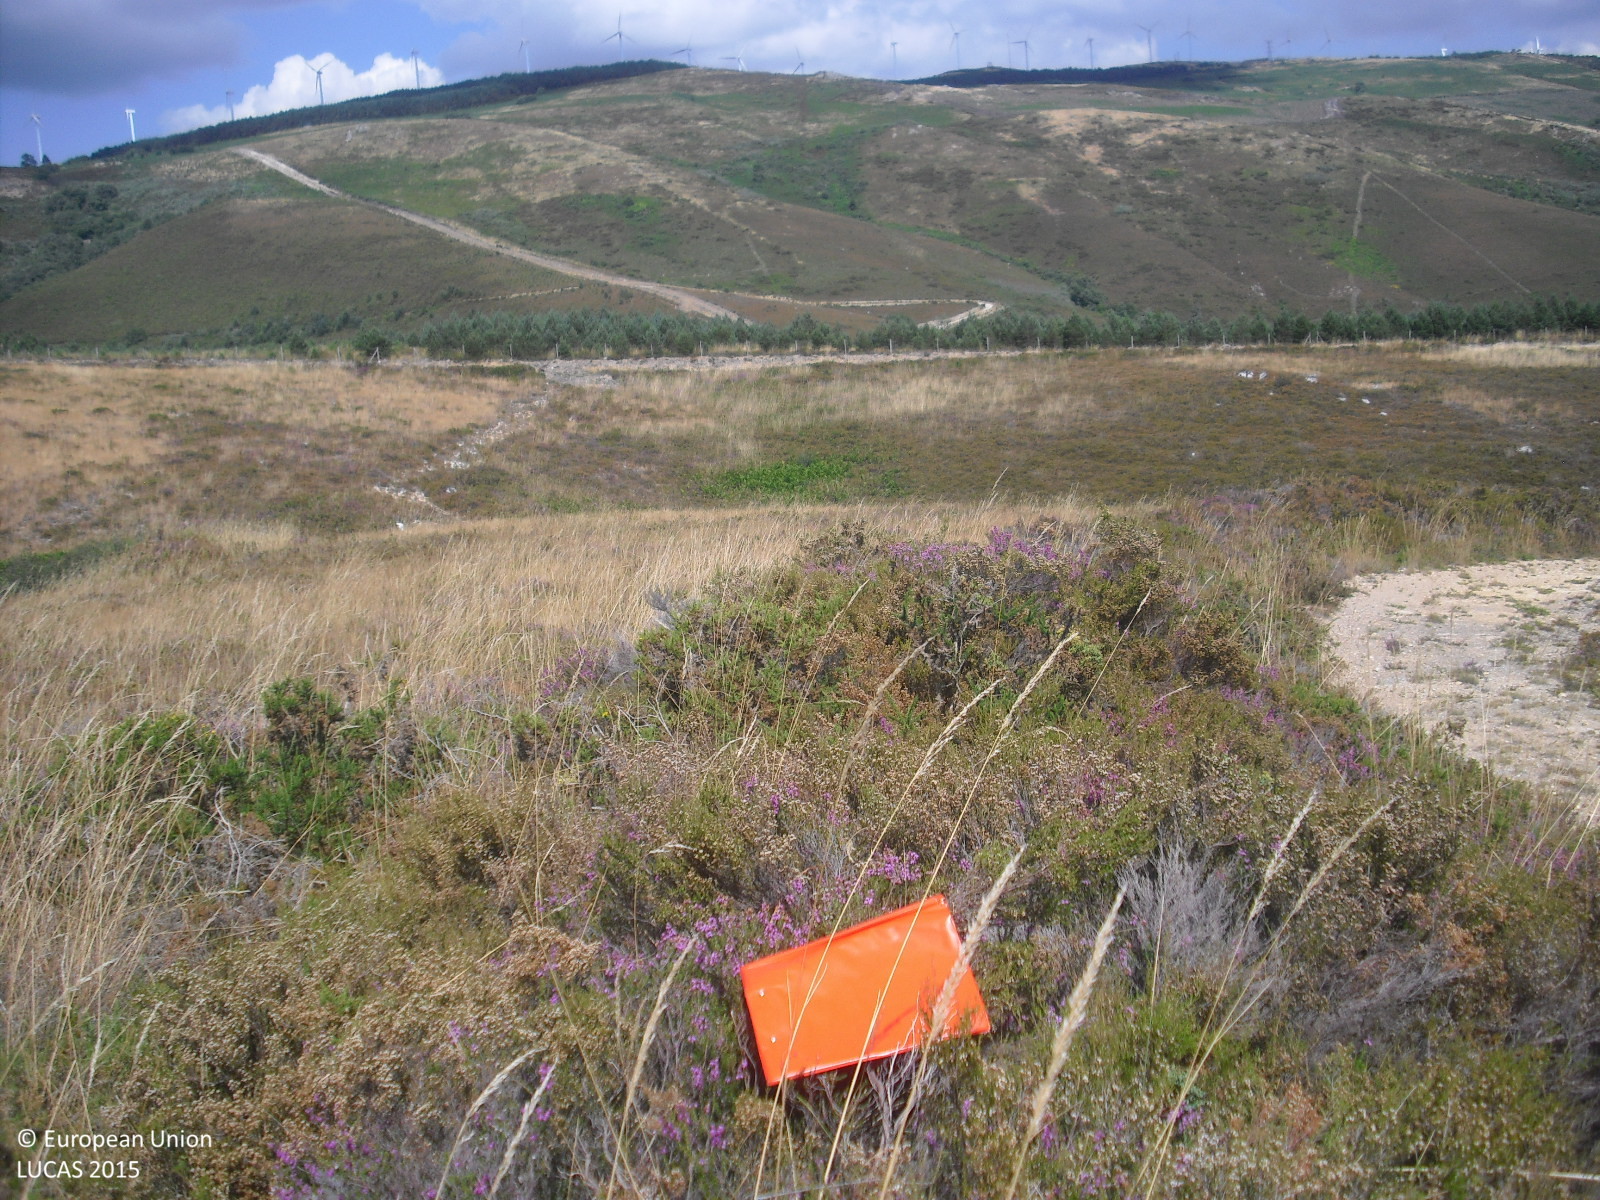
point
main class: Shrubland
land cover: Shrubland without tree cover
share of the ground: > 75 %
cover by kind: shrubs 80 %, unconsolidated bare surface 20 %
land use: Sport
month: July
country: ES
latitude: 42.3594
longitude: -7.6646
